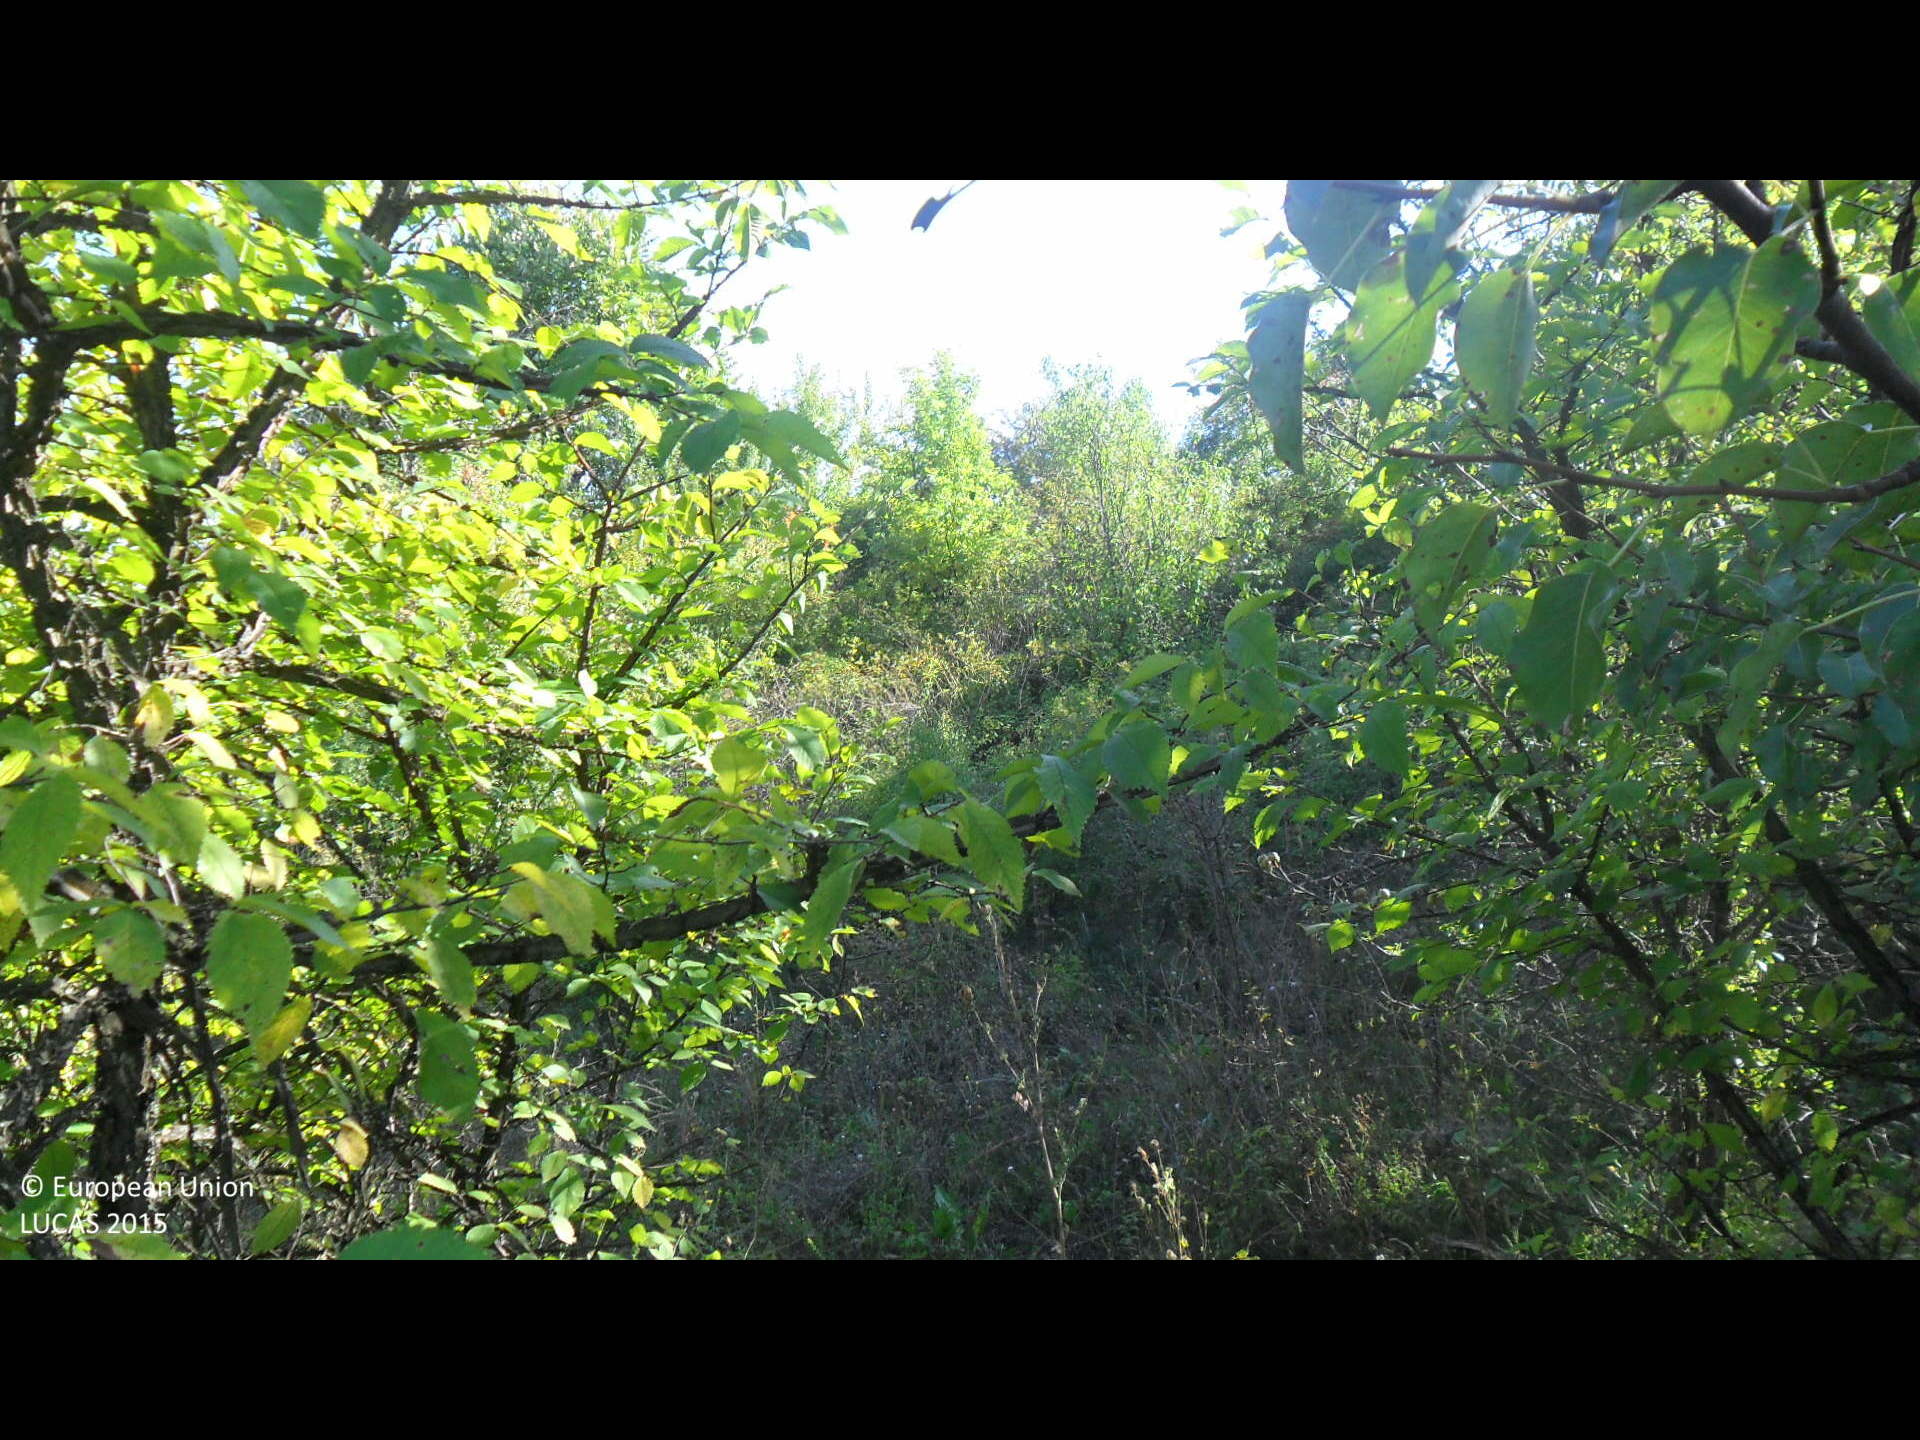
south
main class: Shrubland
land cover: Shrubland with sparse tree cover
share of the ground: > 75 %
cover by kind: shrubs 95 %, broadleaved forest trees 5 %
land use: Semi-natural and natural areas not in use
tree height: > 5 m
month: September
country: BG
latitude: 43.2580
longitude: 26.4975
